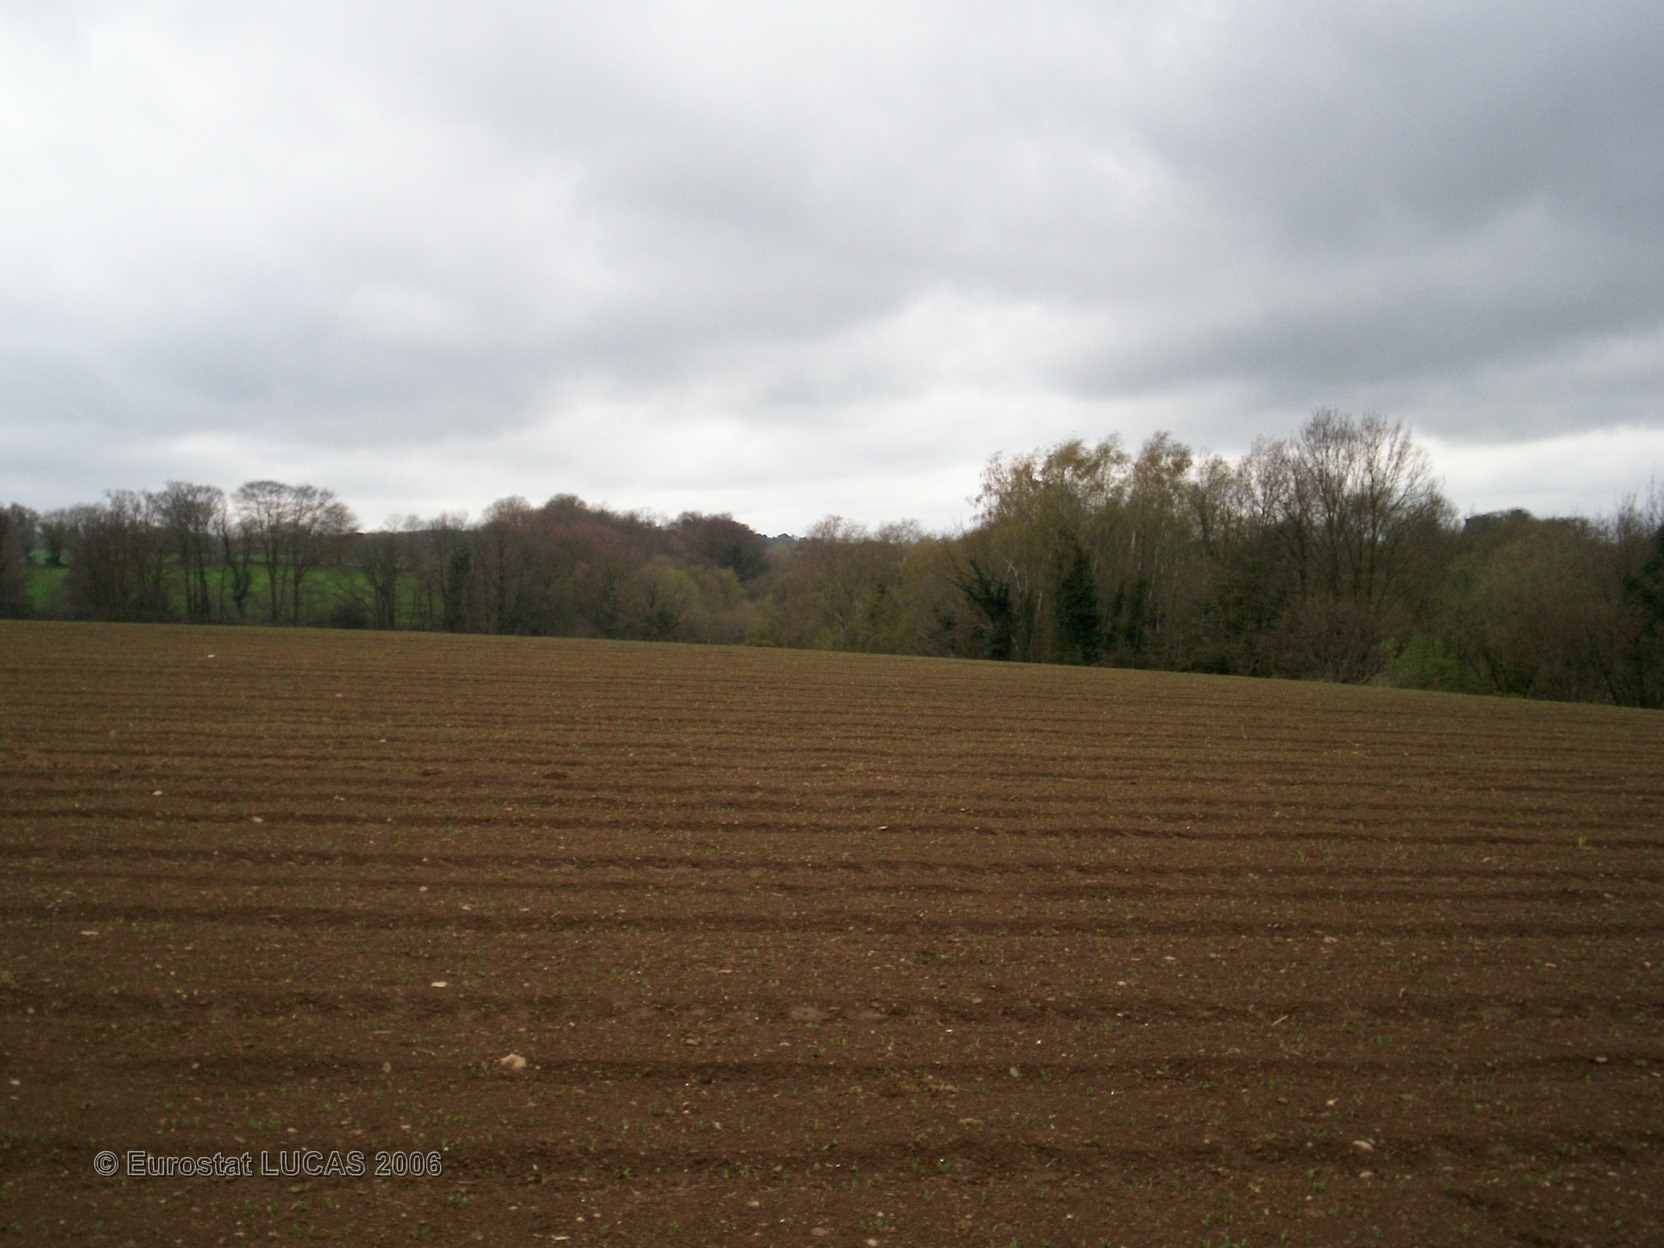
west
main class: Cropland
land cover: Other fresh vegetables
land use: Agriculture (excluding fallow land and kitchen gardens)
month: April
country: FR
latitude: 47.7760
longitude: -2.8622
